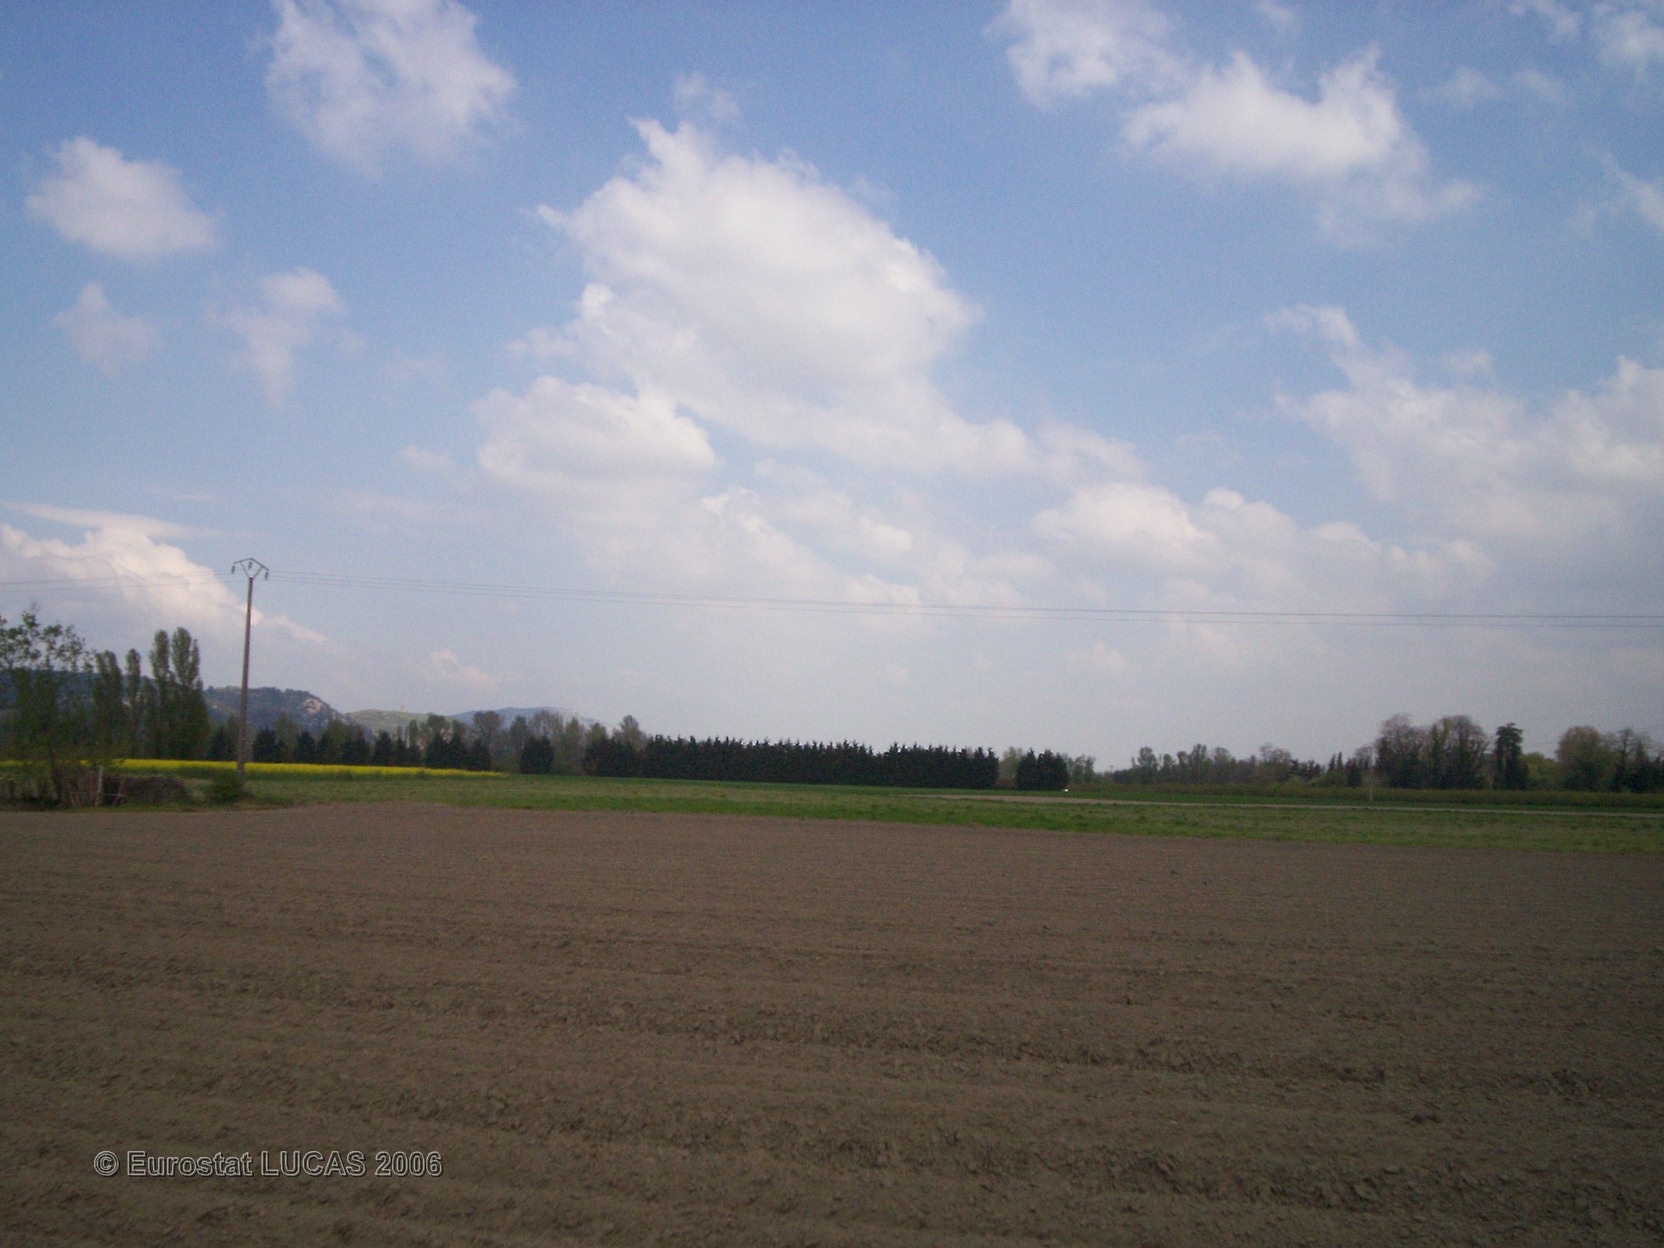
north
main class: Cropland
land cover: Potatoes
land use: Agriculture (excluding fallow land and kitchen gardens)
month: June
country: FR
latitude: 44.8553
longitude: 4.8557
